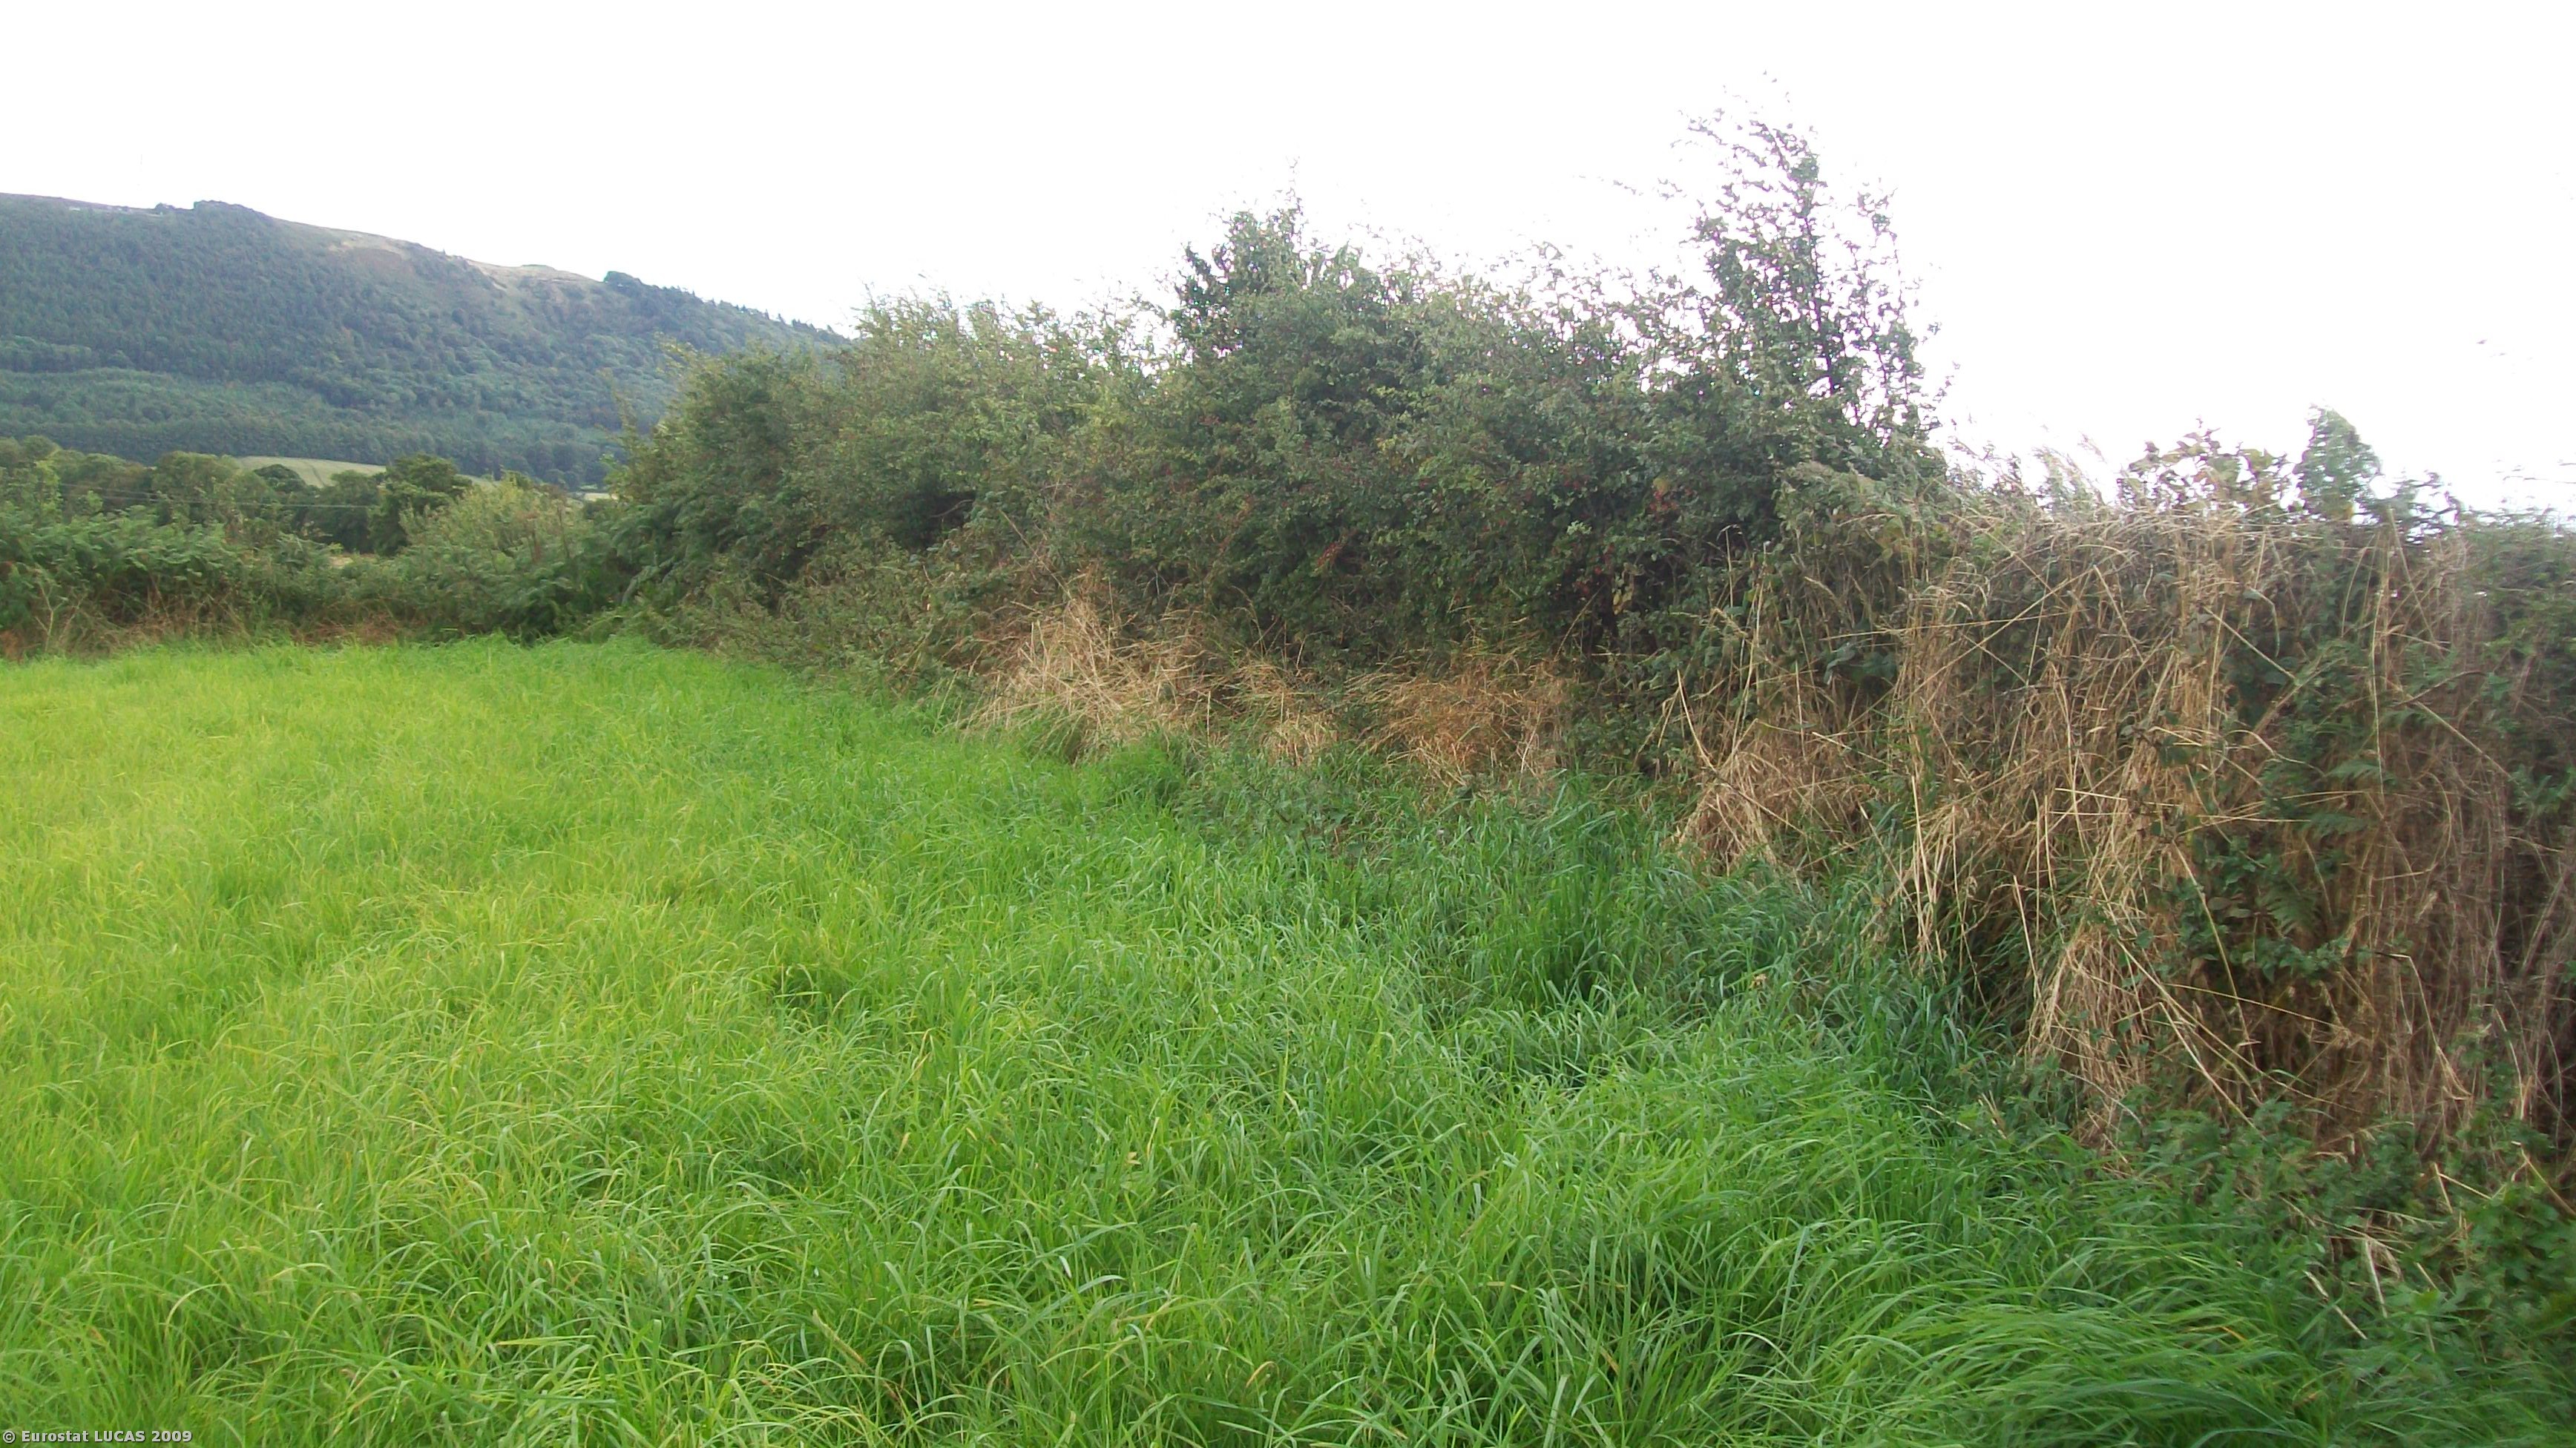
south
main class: Grassland
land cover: Grassland without tree/shrub cover
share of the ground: > 75 %
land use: Agriculture (excluding fallow land and kitchen gardens)
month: September
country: GB
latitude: 52.6892
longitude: -2.5686
